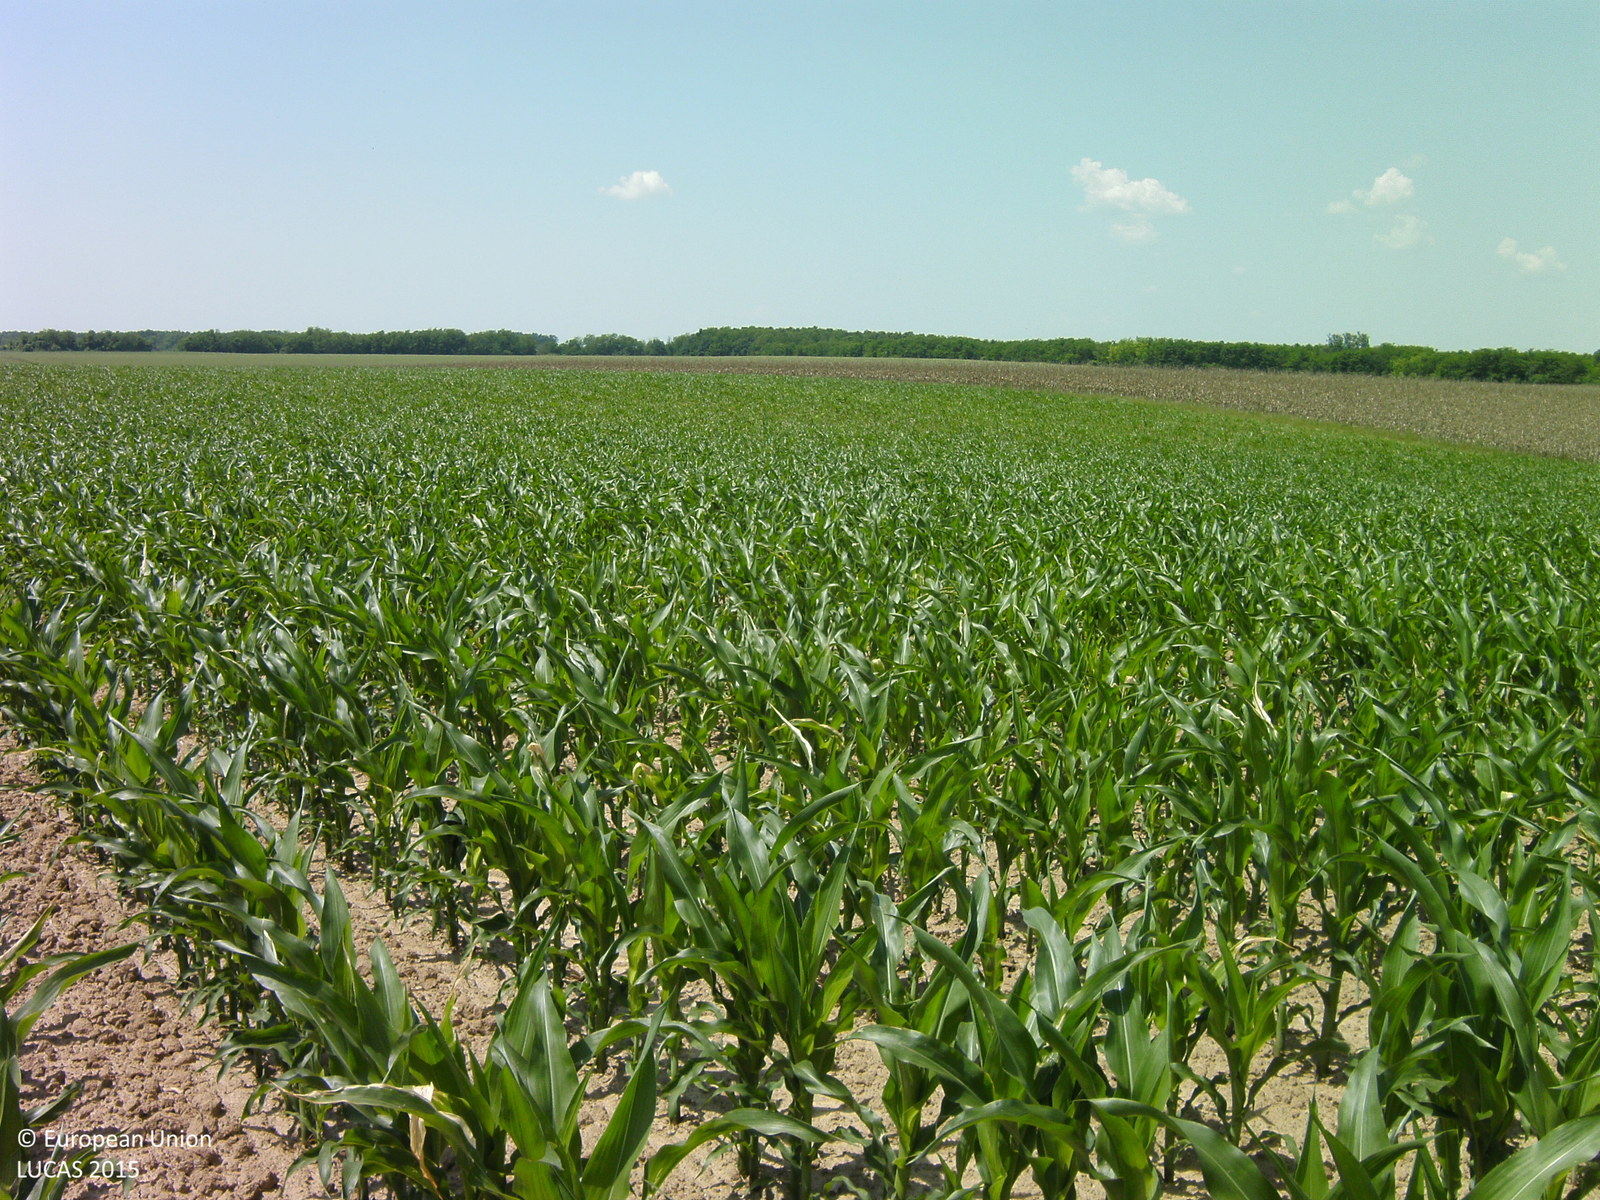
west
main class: Cropland
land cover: Maize
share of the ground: 25 - 50 %
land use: Agriculture (excluding fallow land and kitchen gardens)
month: June
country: HU
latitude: 46.3996
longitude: 17.6923
